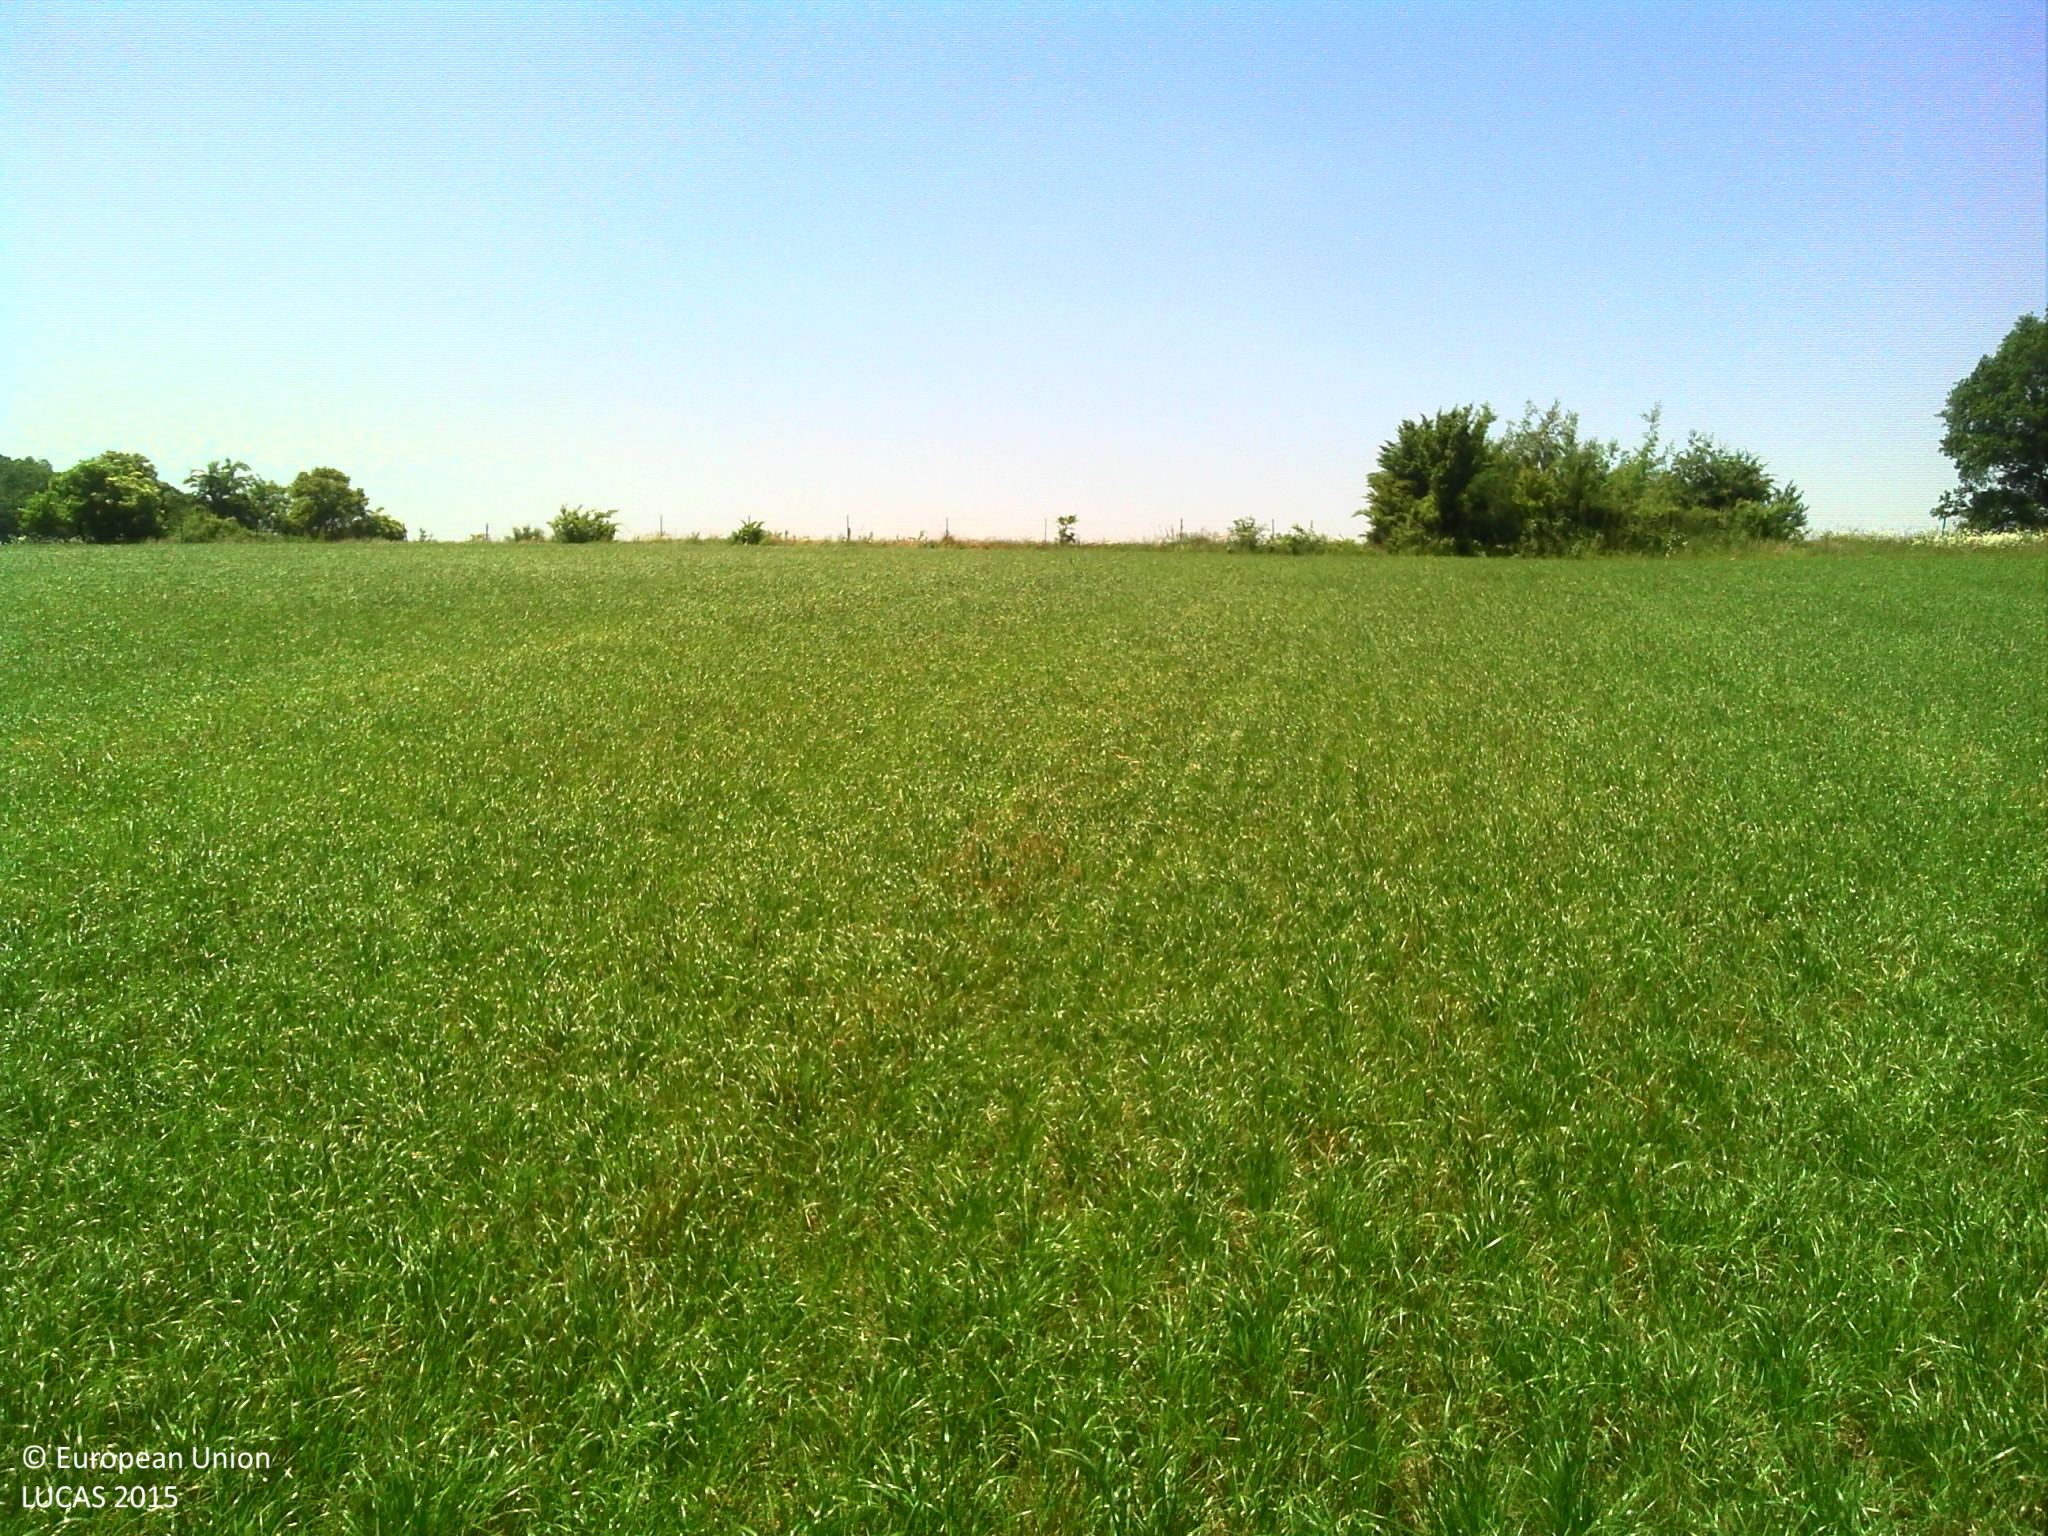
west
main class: Cropland
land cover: Temporary grasslands
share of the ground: > 75 %
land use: Agriculture (excluding fallow land and kitchen gardens)
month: June
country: FR
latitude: 49.8933
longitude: 4.2183
